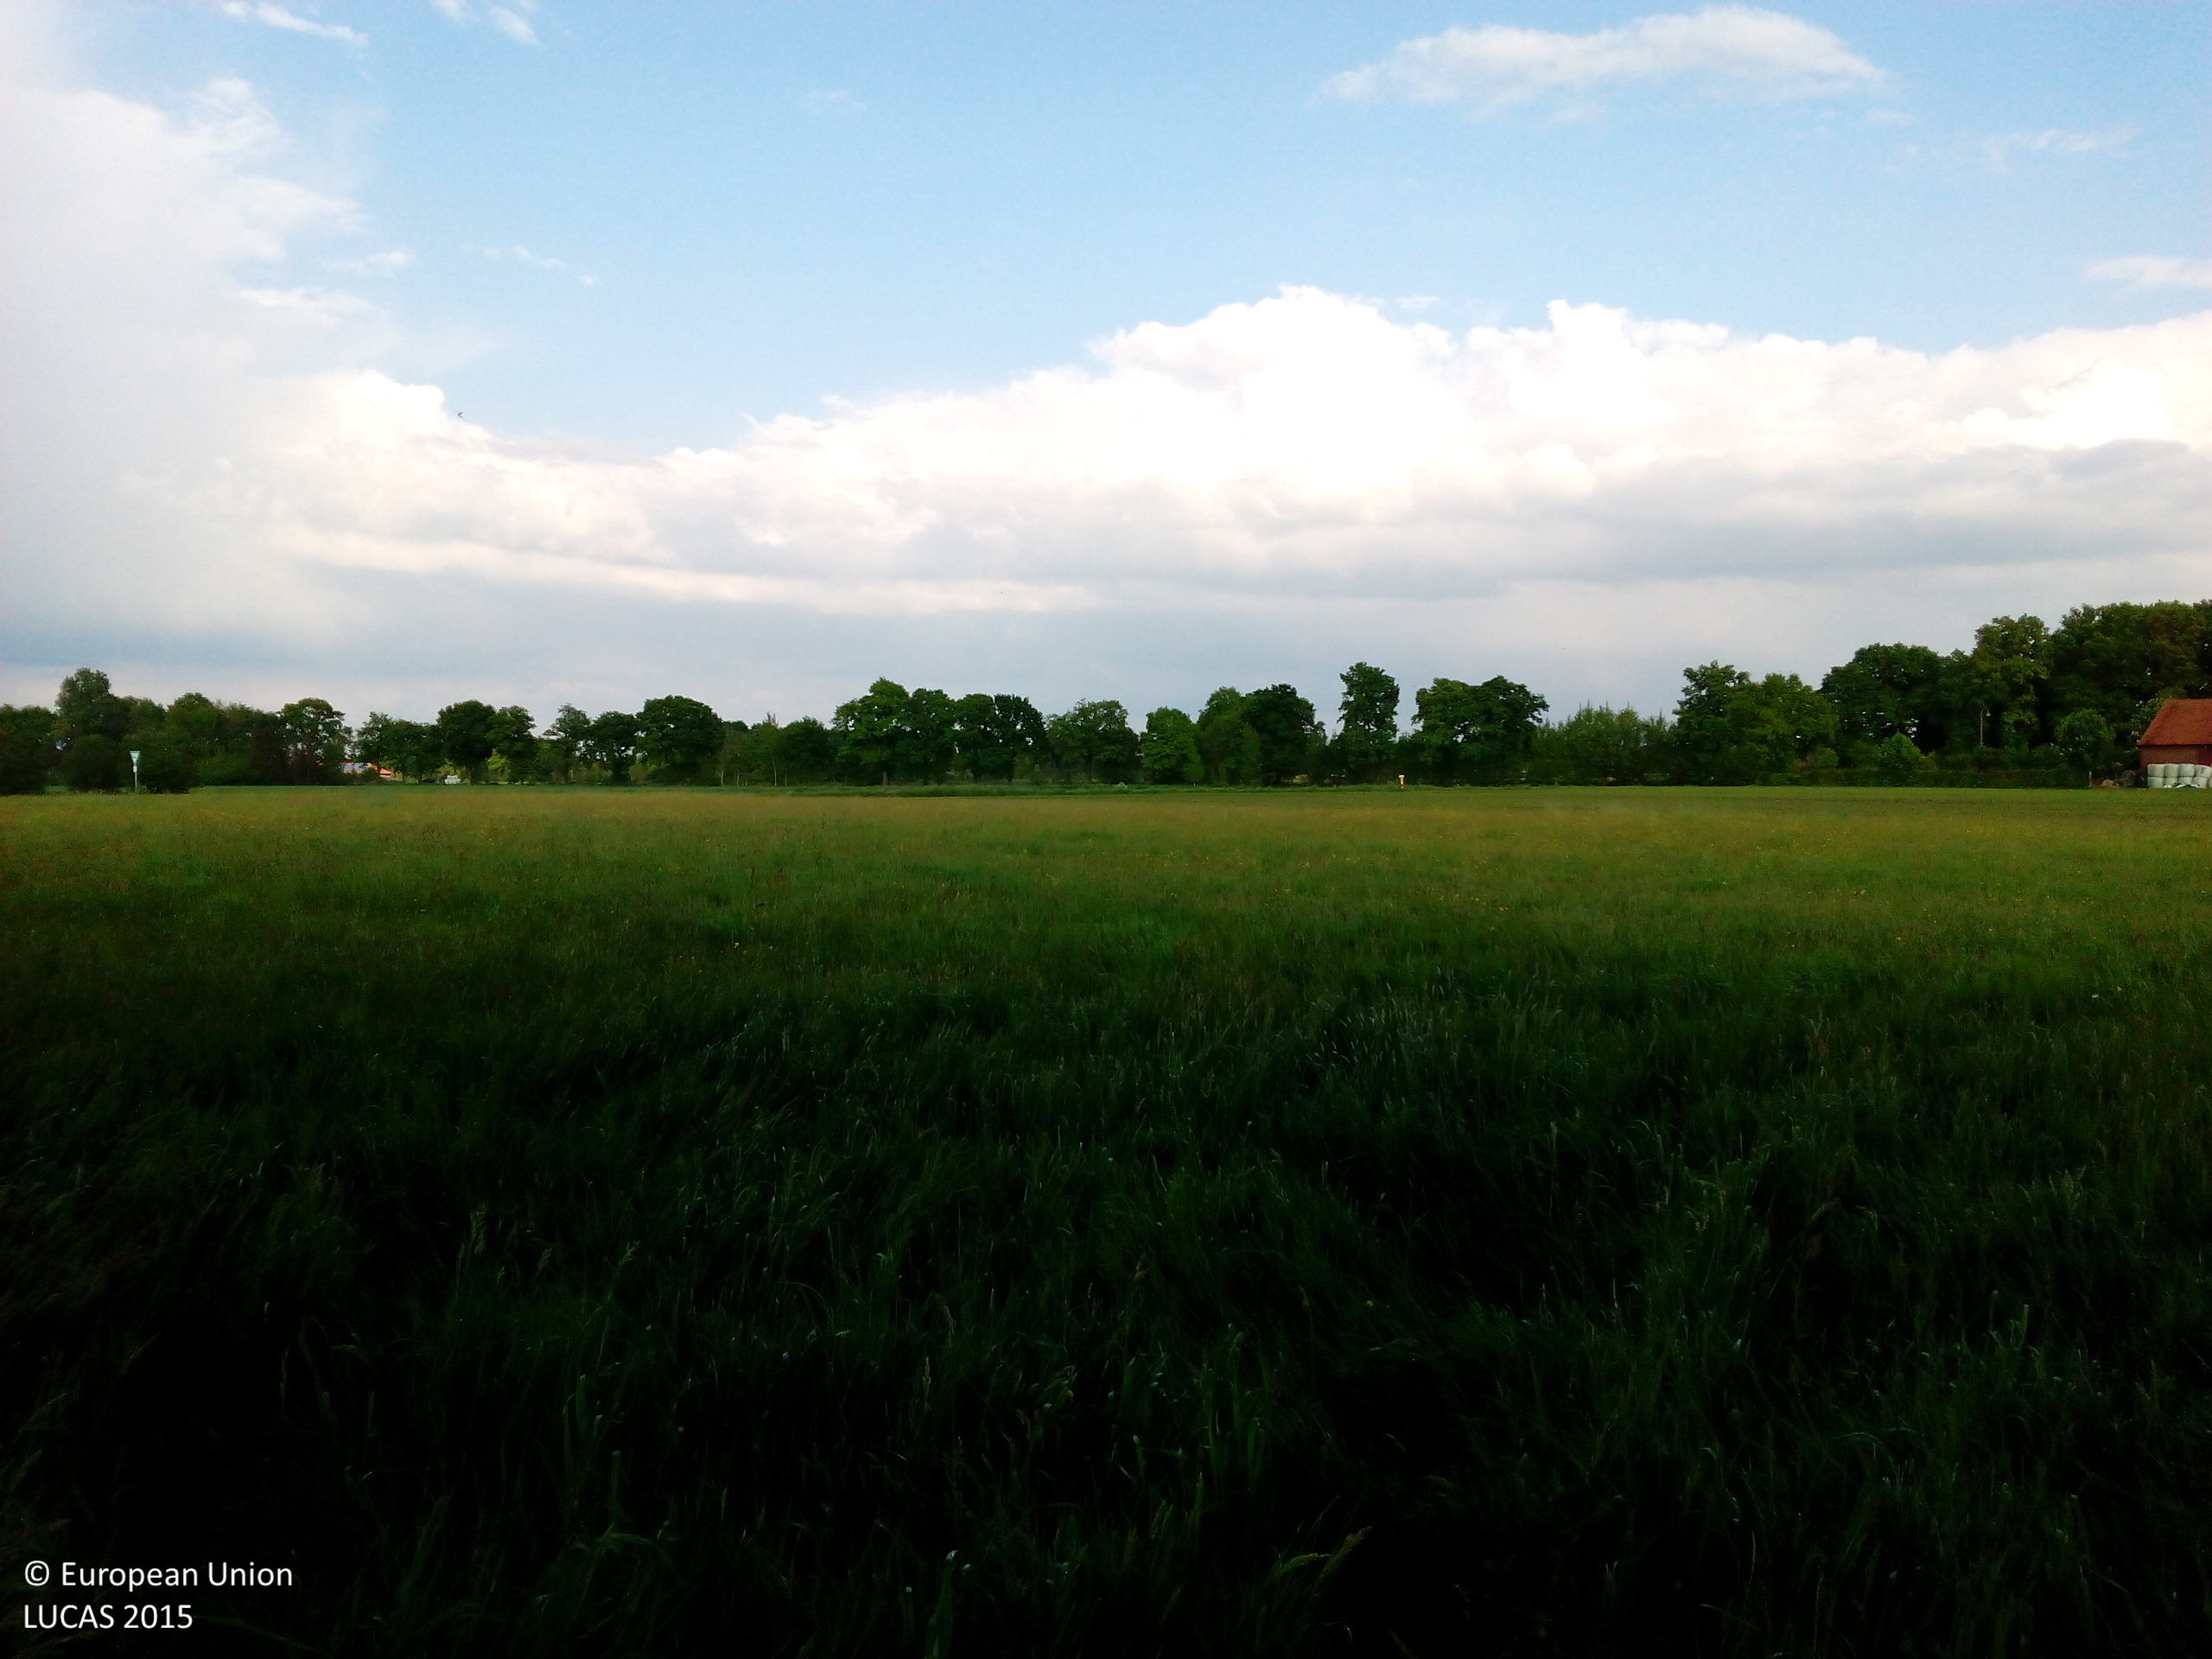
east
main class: Woodland
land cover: Broadleaved woodland
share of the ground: > 75 %
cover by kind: broadleaved forest trees 60 %, shrubs 20 %, herbaceous plants 20 %
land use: Agriculture (excluding fallow land and kitchen gardens)
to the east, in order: Broadleaved woodland; Grassland without tree/shrub cover; Shruby margins; Paved roads, cycling and walking lanes; Grass margins; Maize
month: May
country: DE
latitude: 52.1707
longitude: 7.4708
